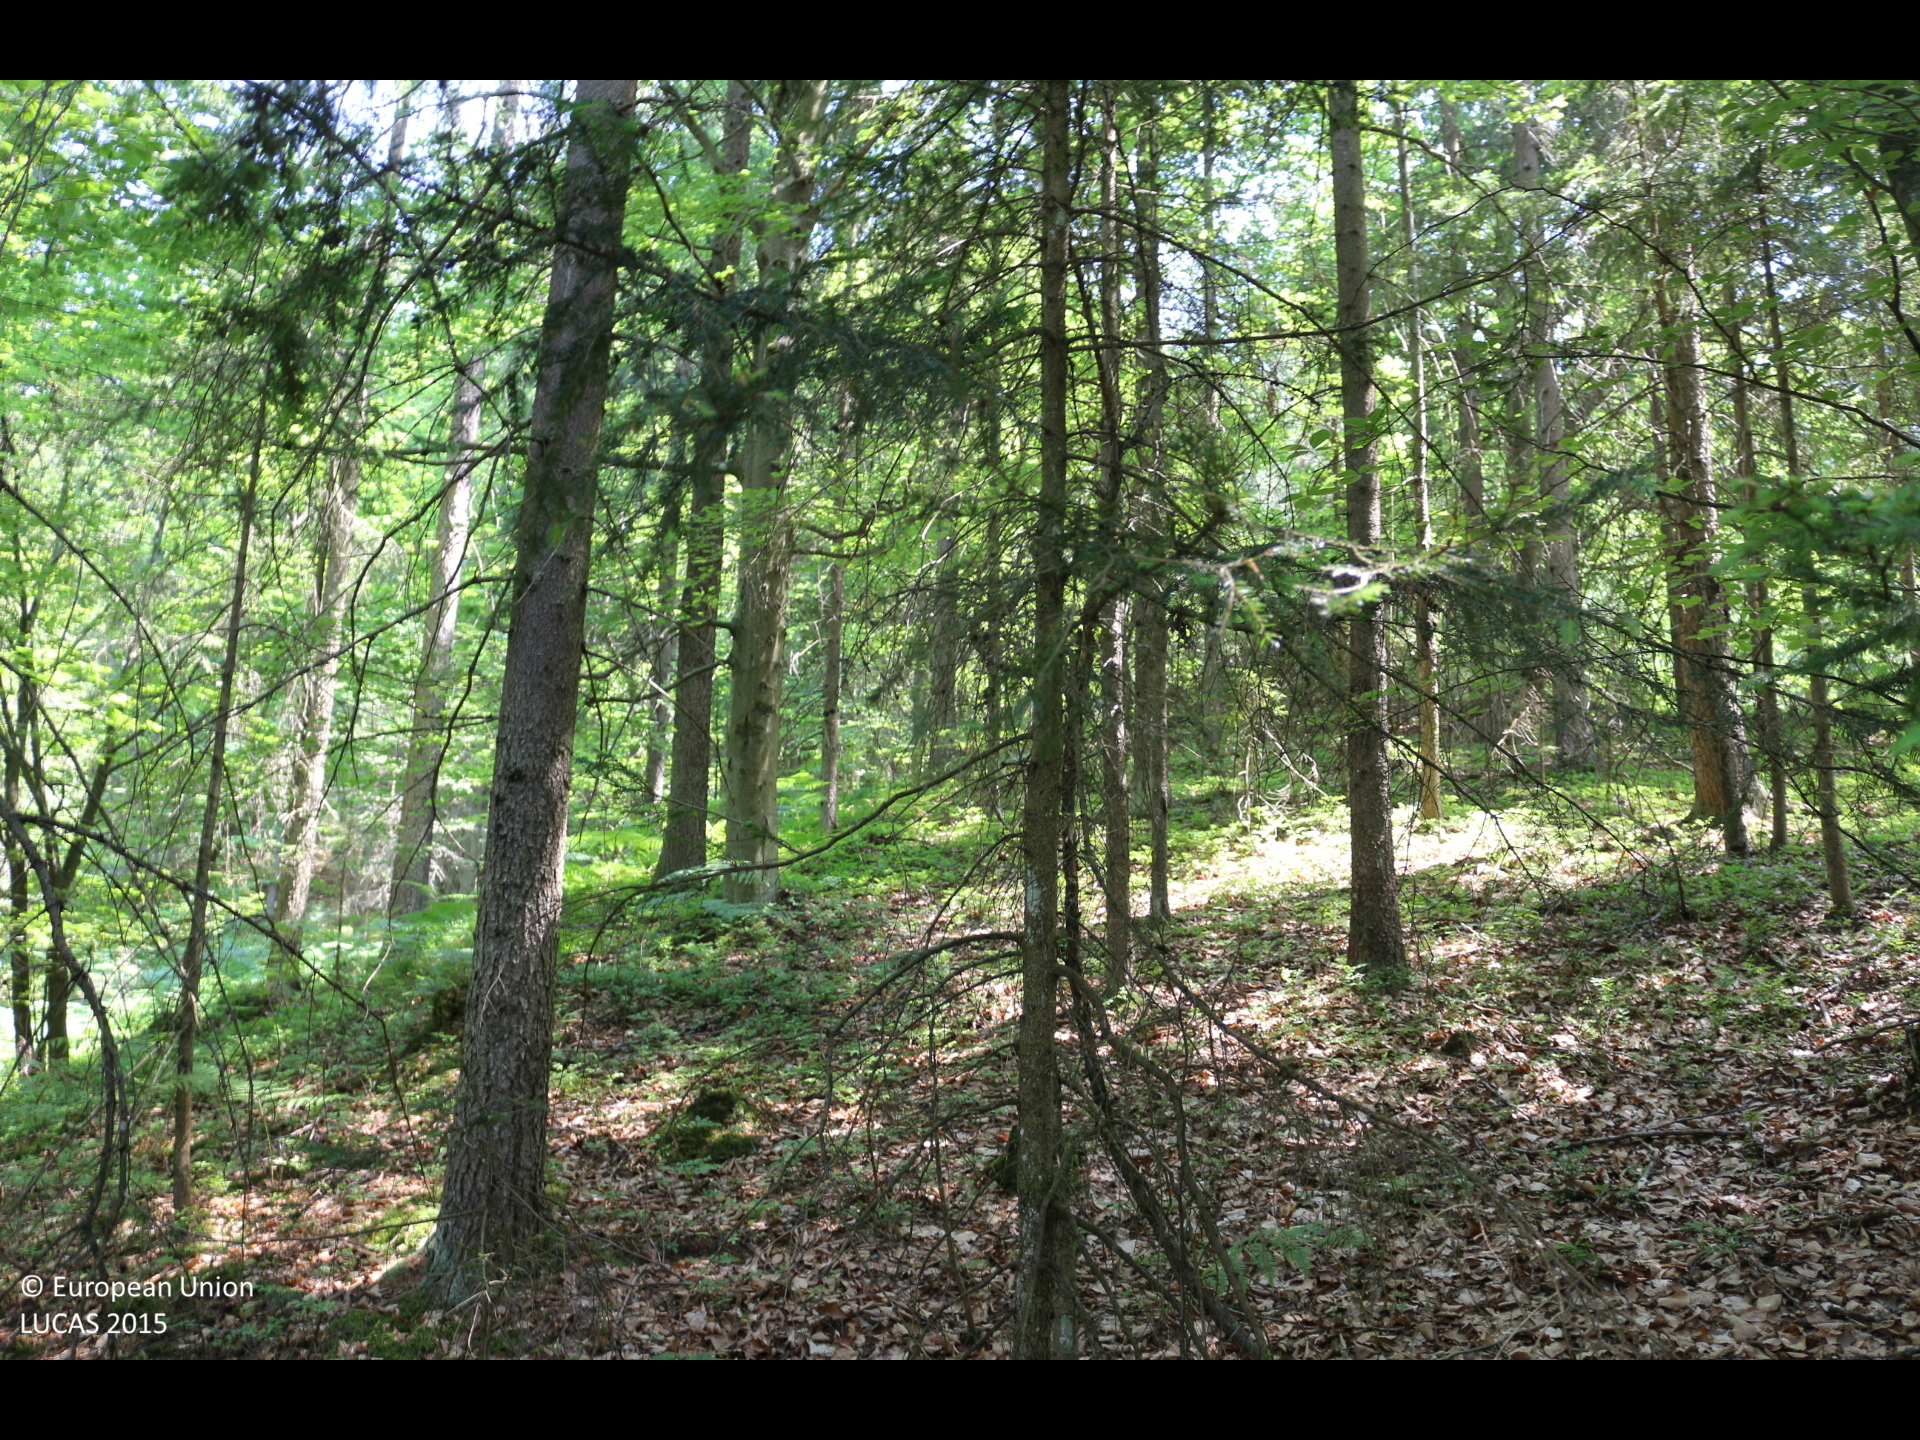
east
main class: Woodland
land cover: Spruce dominated mixed woodland
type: alpine coniferous forest
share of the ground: > 75 %
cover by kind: coniferous forest trees 70 %, broadleaved forest trees 30 %
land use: Forestry
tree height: > 5 m
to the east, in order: Spruce dominated mixed woodland; Spruce dominated coniferous woodland; Spruce dominated mixed woodland; Other mixed woodland
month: June
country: AT
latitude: 46.5658
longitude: 13.9762
